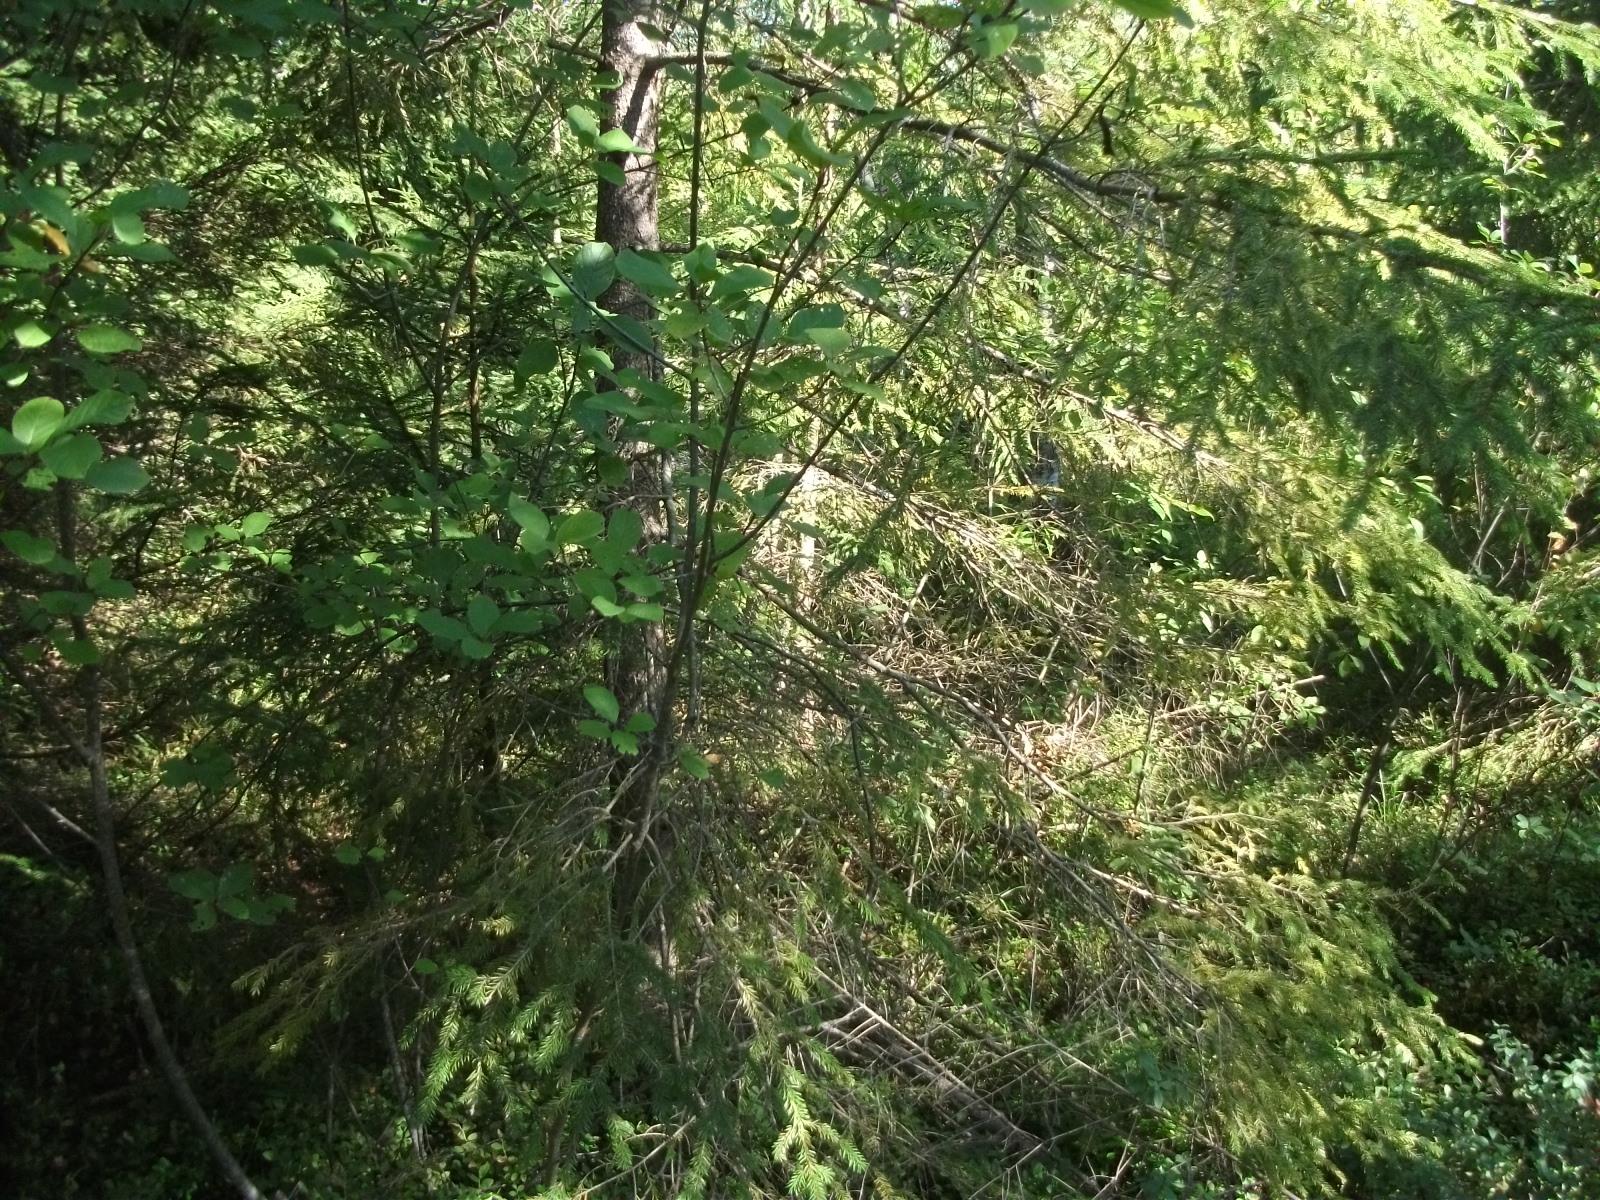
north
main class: Woodland
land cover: Spruce dominated mixed woodland
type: hemiboreal forest and nemoral coniferous forest and mixed broadleaved-coniferous forest
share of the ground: > 75 %
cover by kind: coniferous forest trees 55 %, broadleaved forest trees 25 %, herbaceous plants 15 %, shrubs 5 %
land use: Forestry
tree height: > 5 m
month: August
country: LV
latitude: 56.4338
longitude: 26.2109
